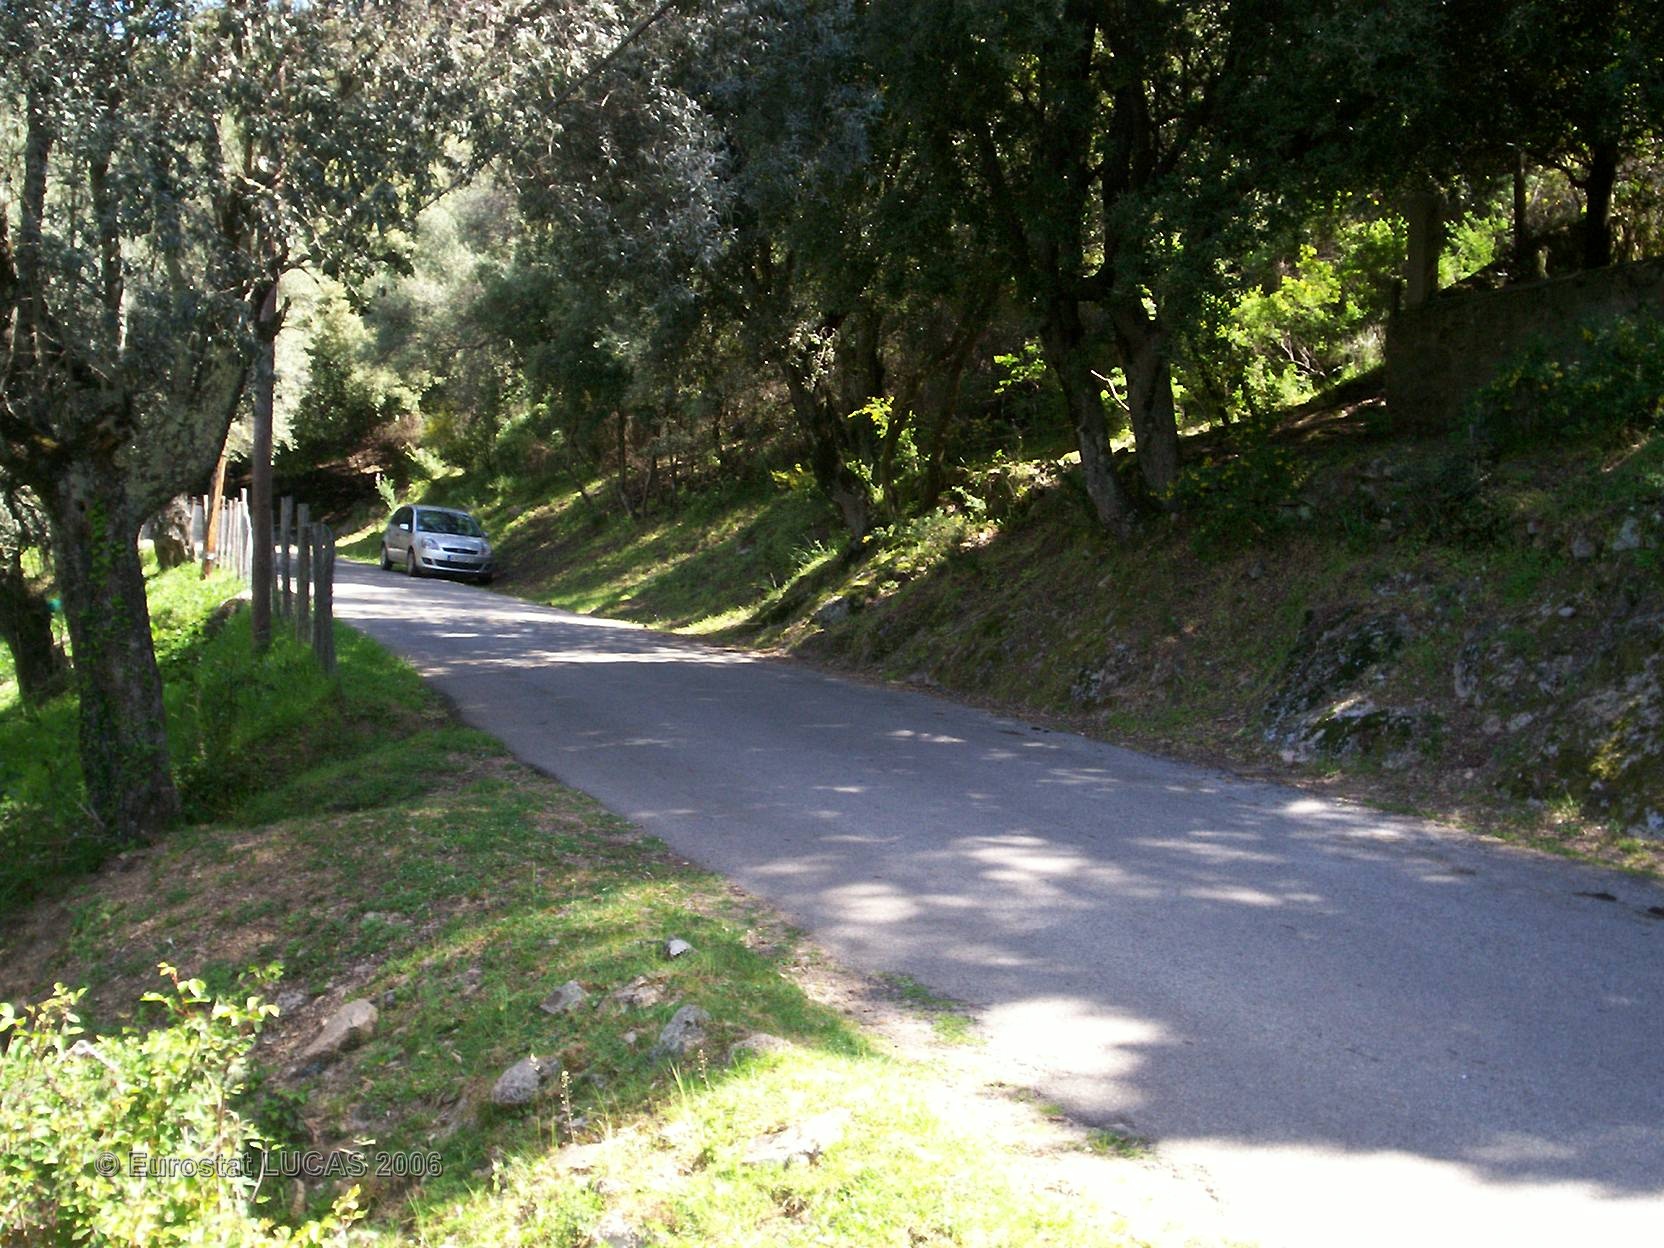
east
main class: Cropland
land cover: Olive groves
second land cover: Shrubland with sparse tree cover
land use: Unused
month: April
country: FR
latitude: 42.1225
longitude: 8.7587
